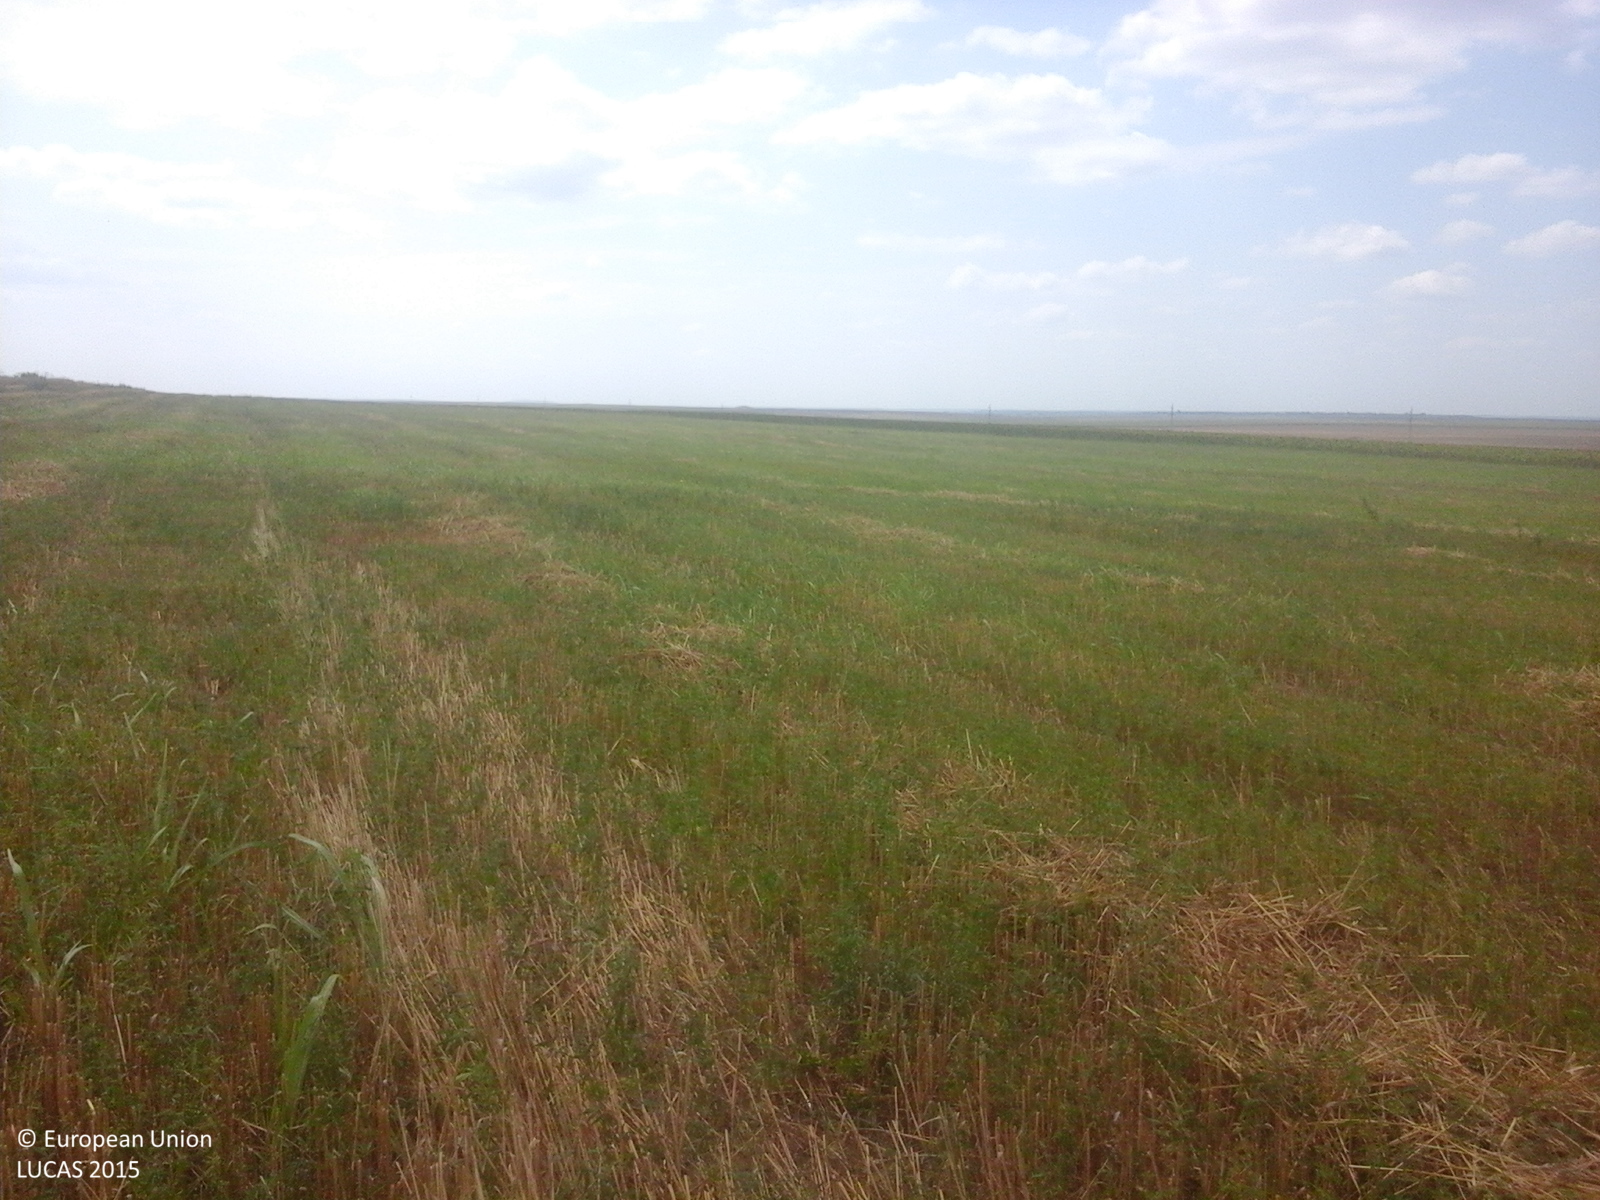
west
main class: Cropland
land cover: Common wheat
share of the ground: 25 - 50 %
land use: Agriculture (excluding fallow land and kitchen gardens)
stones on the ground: < 10 %
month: August
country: RO
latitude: 44.7727
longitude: 28.1989
